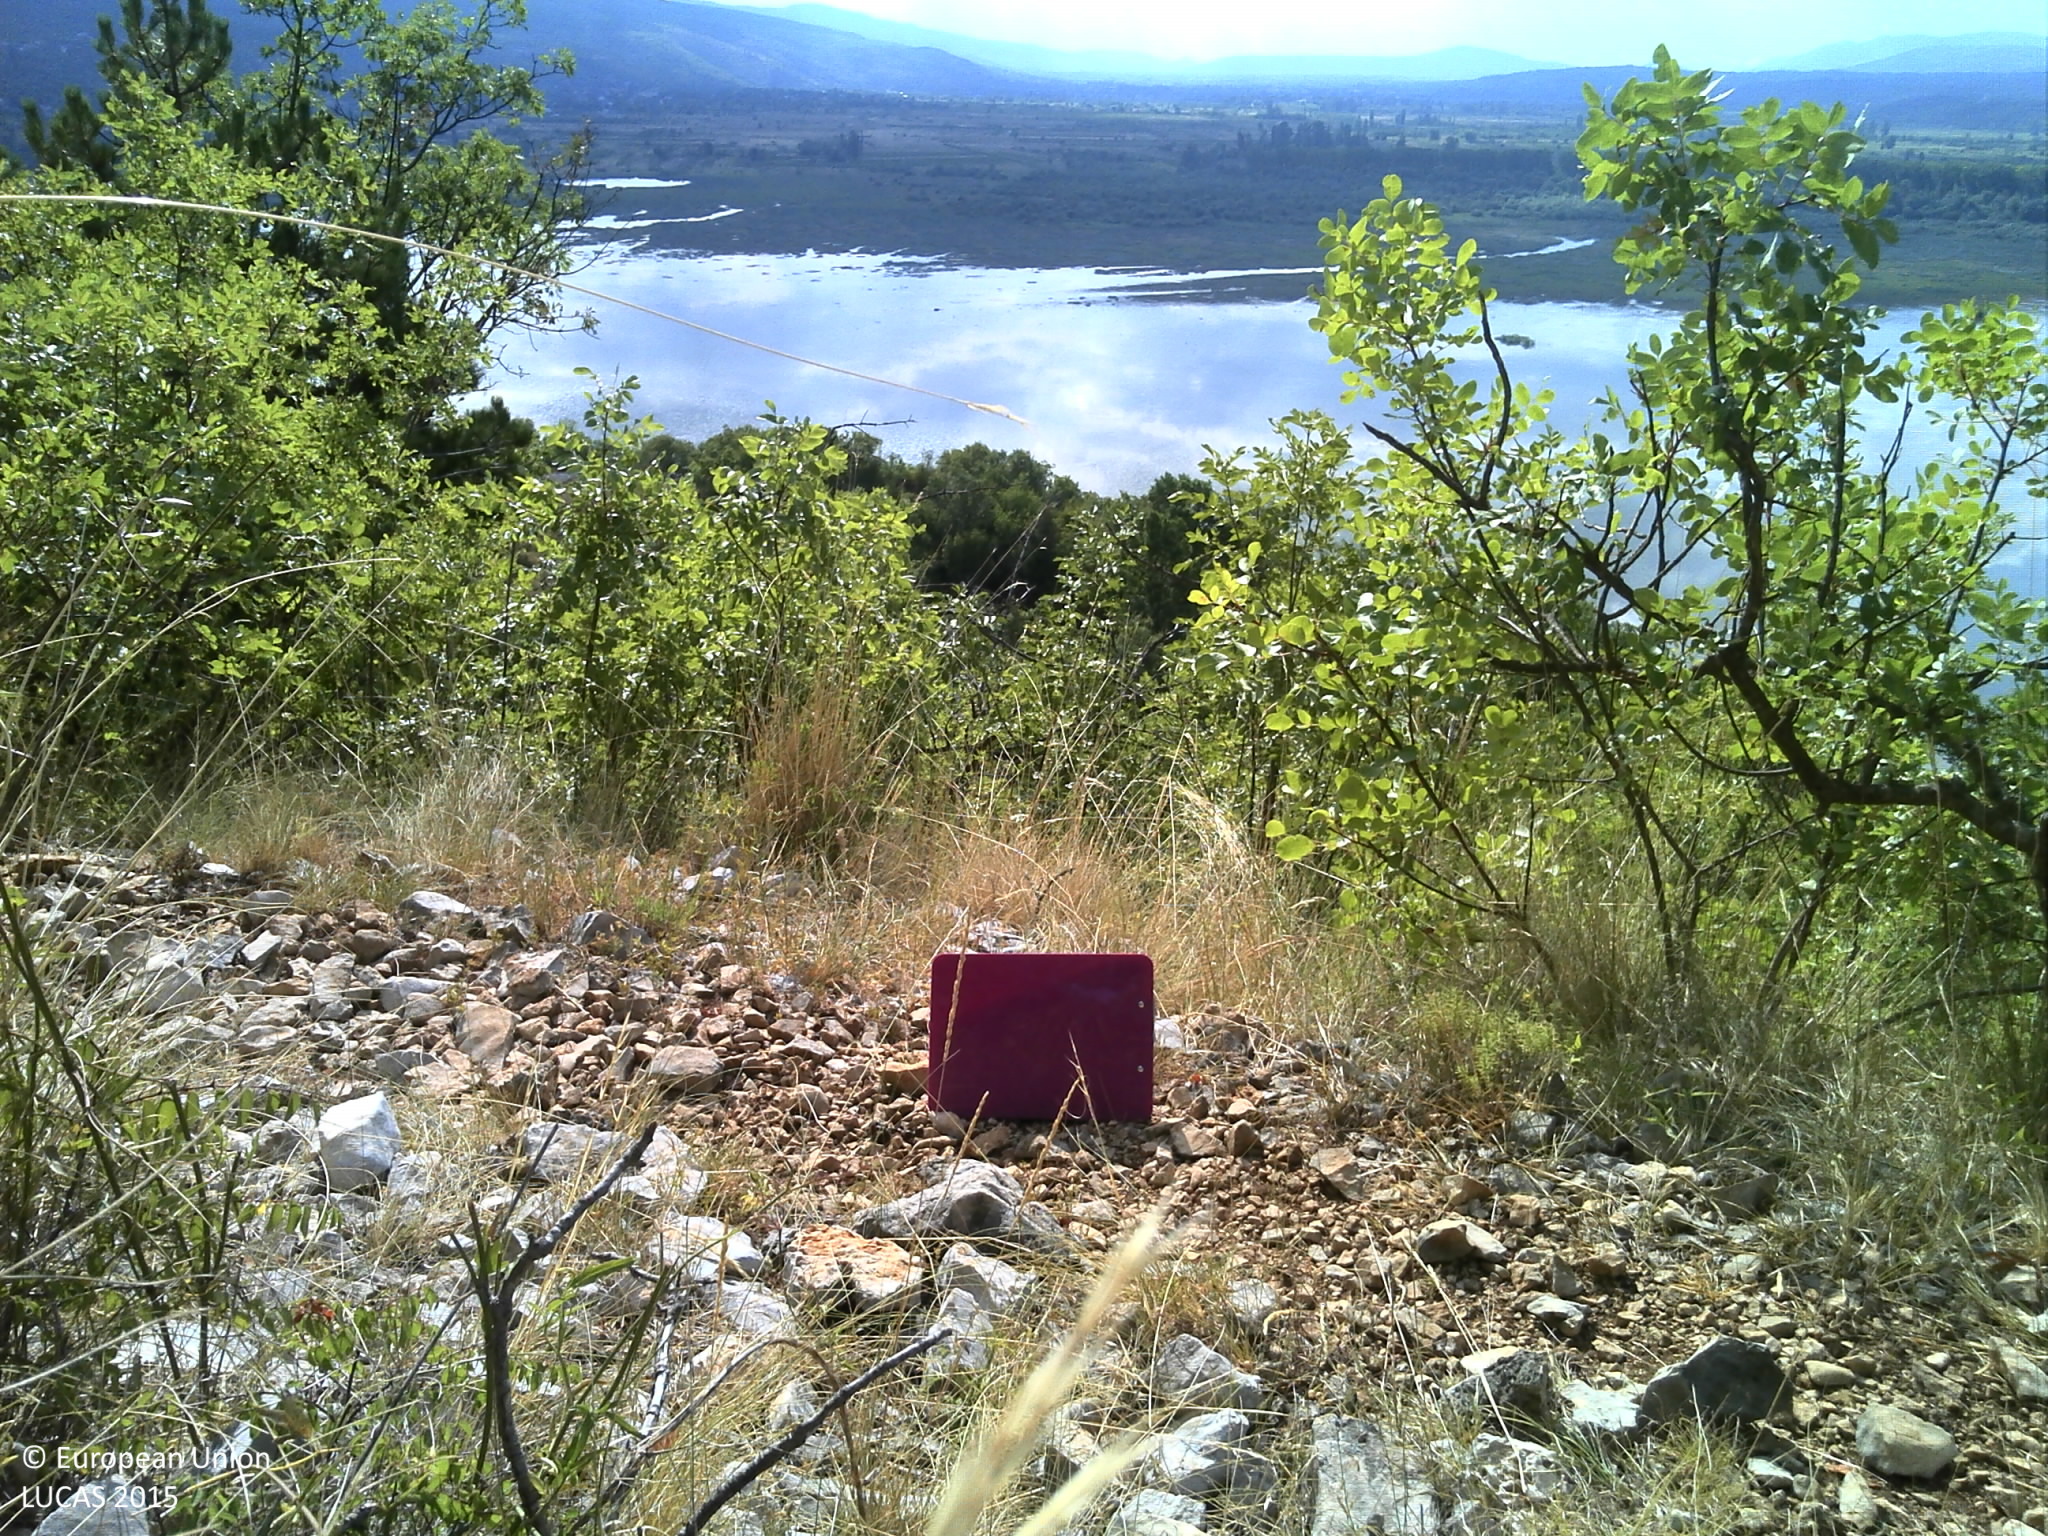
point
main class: Shrubland
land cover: Shrubland with sparse tree cover
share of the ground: 50 - 75 %
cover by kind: shrubs 60 %, consolidated bare surface 15 %, herbaceous plants 10 %, unconsolidated bare surface 10 %, broadleaved forest trees 5 %
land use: Semi-natural and natural areas not in use
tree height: < 5 m
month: July
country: HR
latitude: 43.4735
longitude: 17.1000
